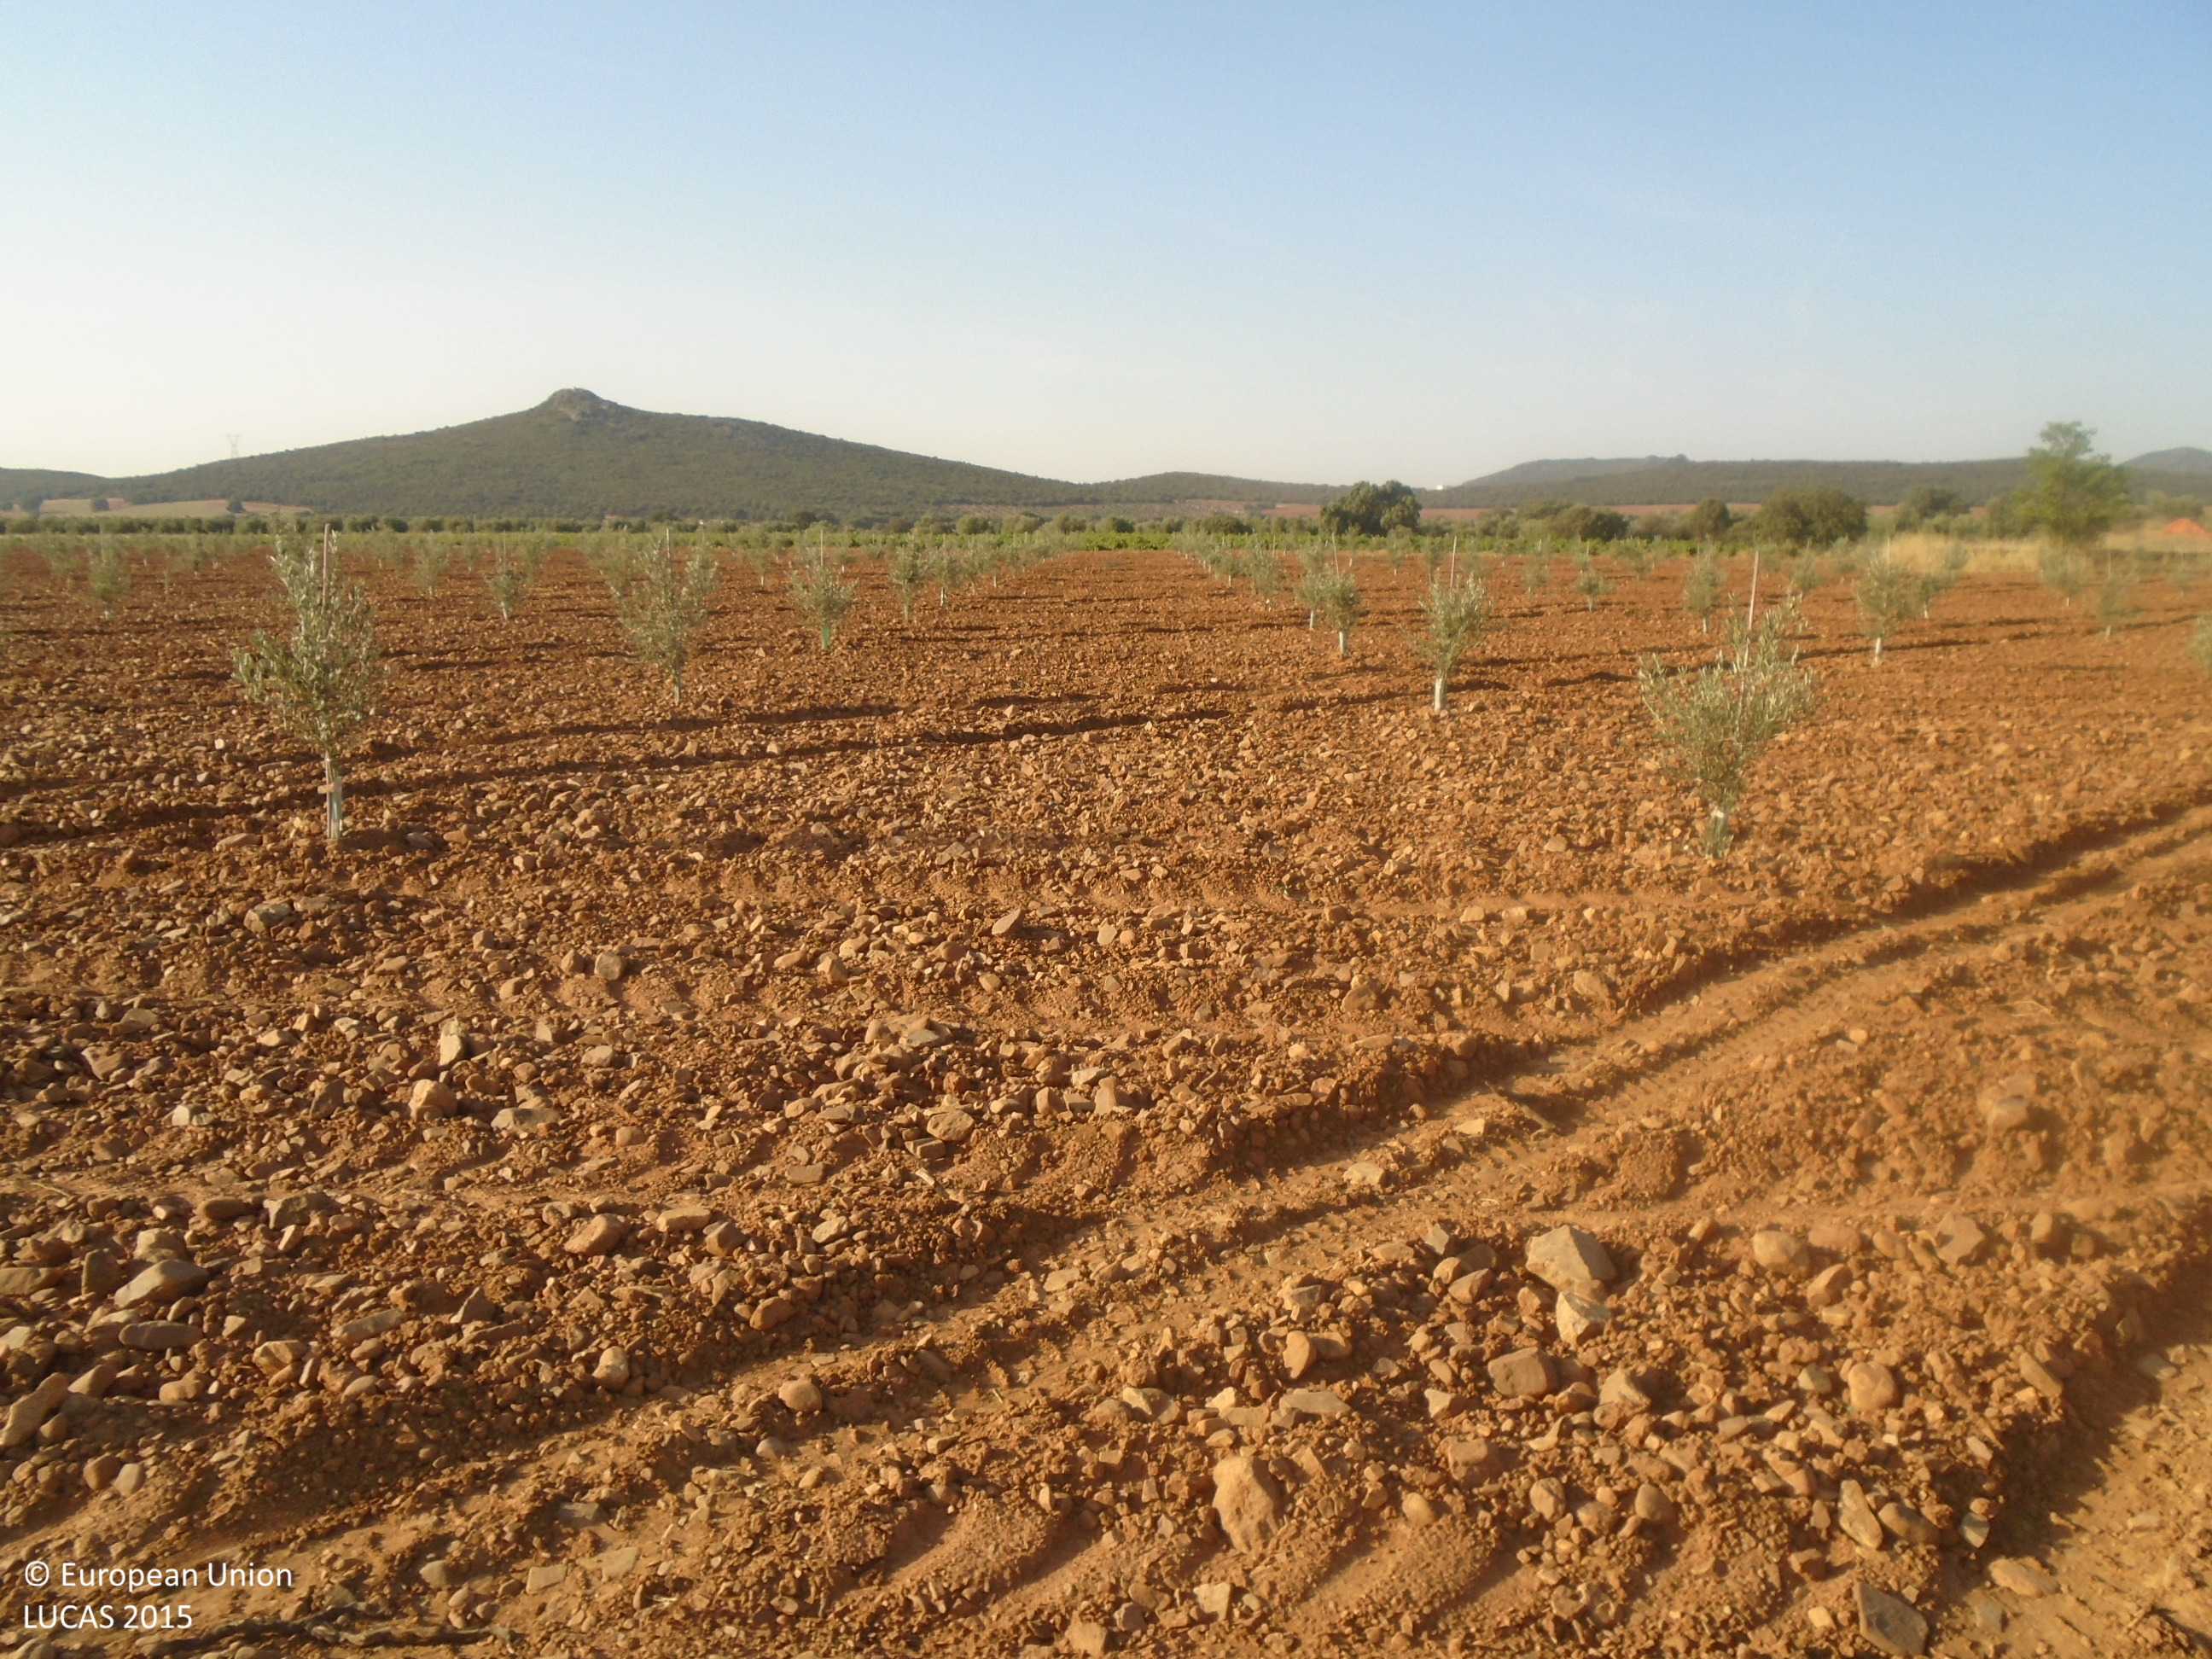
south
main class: Cropland
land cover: Olive groves
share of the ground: < 10 %
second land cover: Other bare soil
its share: > 75 %
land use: Agriculture (excluding fallow land and kitchen gardens)
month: July
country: ES
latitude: 39.3457
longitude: -3.5154
